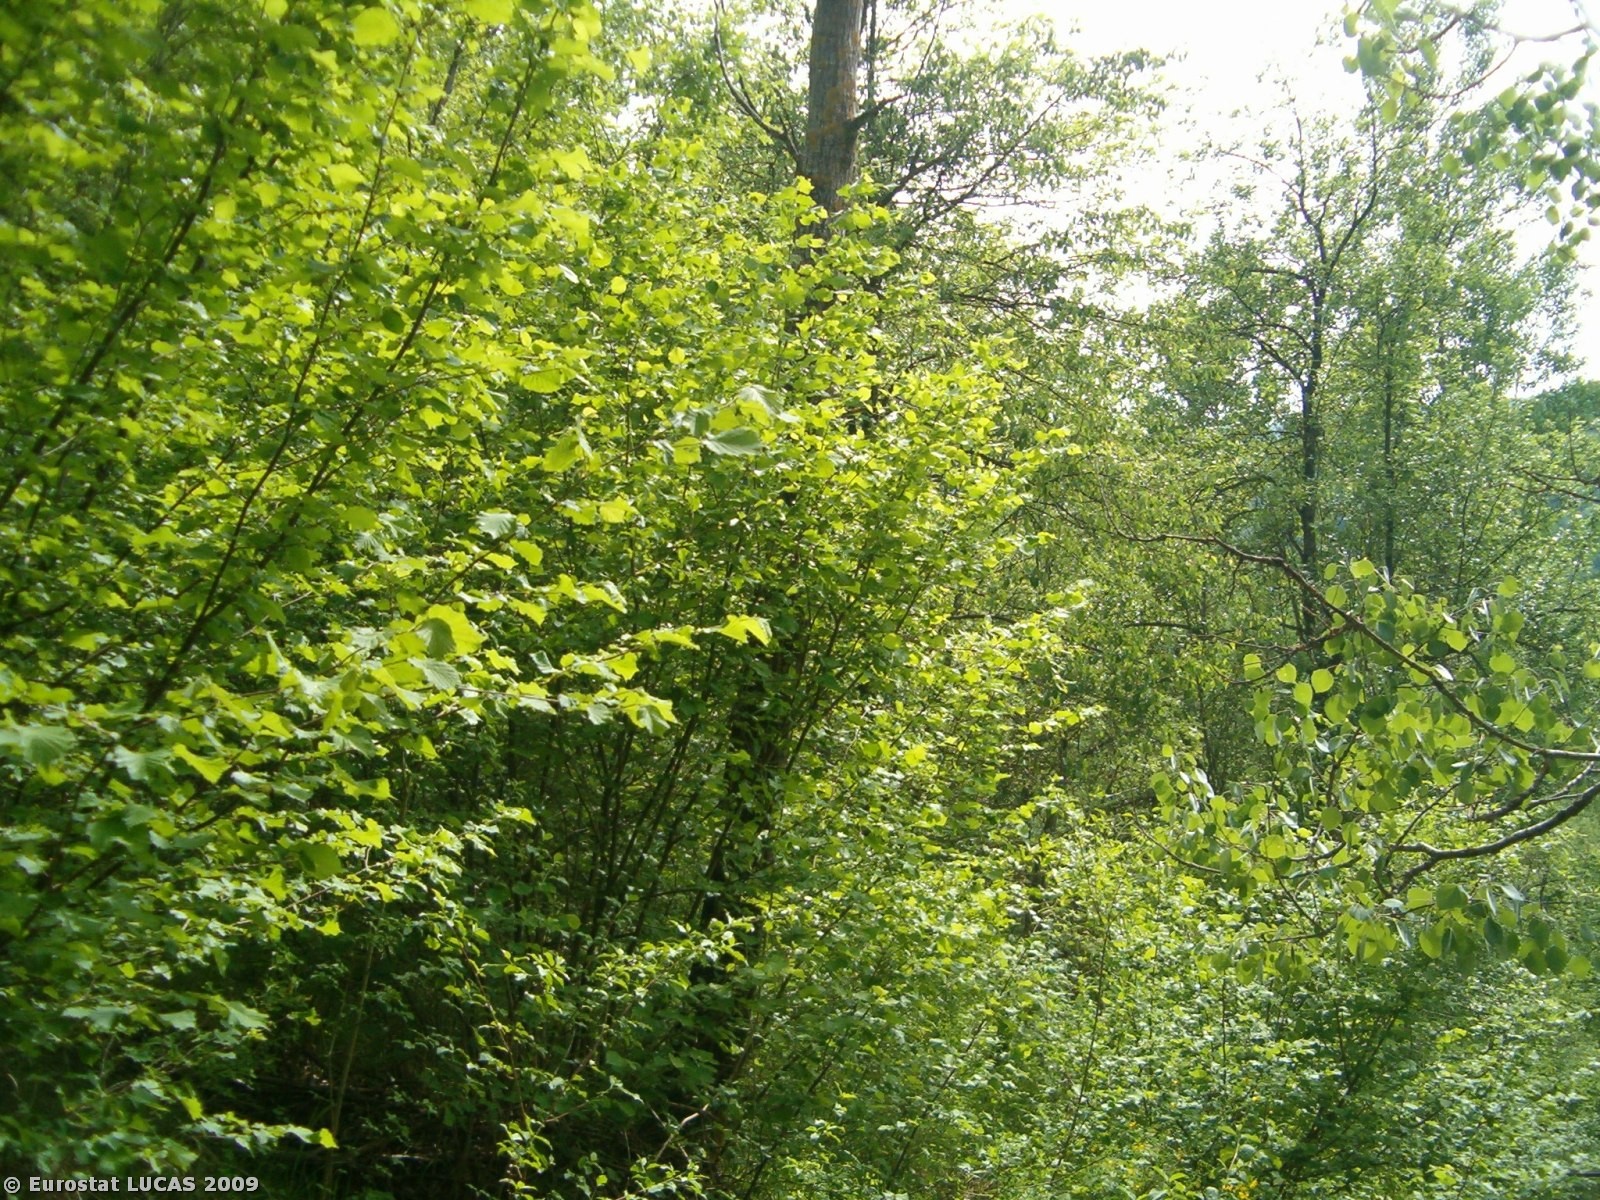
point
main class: Woodland
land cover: Broadleaved woodland
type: thermophilous deciduous forest
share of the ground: > 75 %
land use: Forestry
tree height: > 5 m
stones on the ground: < 10 %
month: May
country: IT
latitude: 42.1148
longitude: 13.2182
